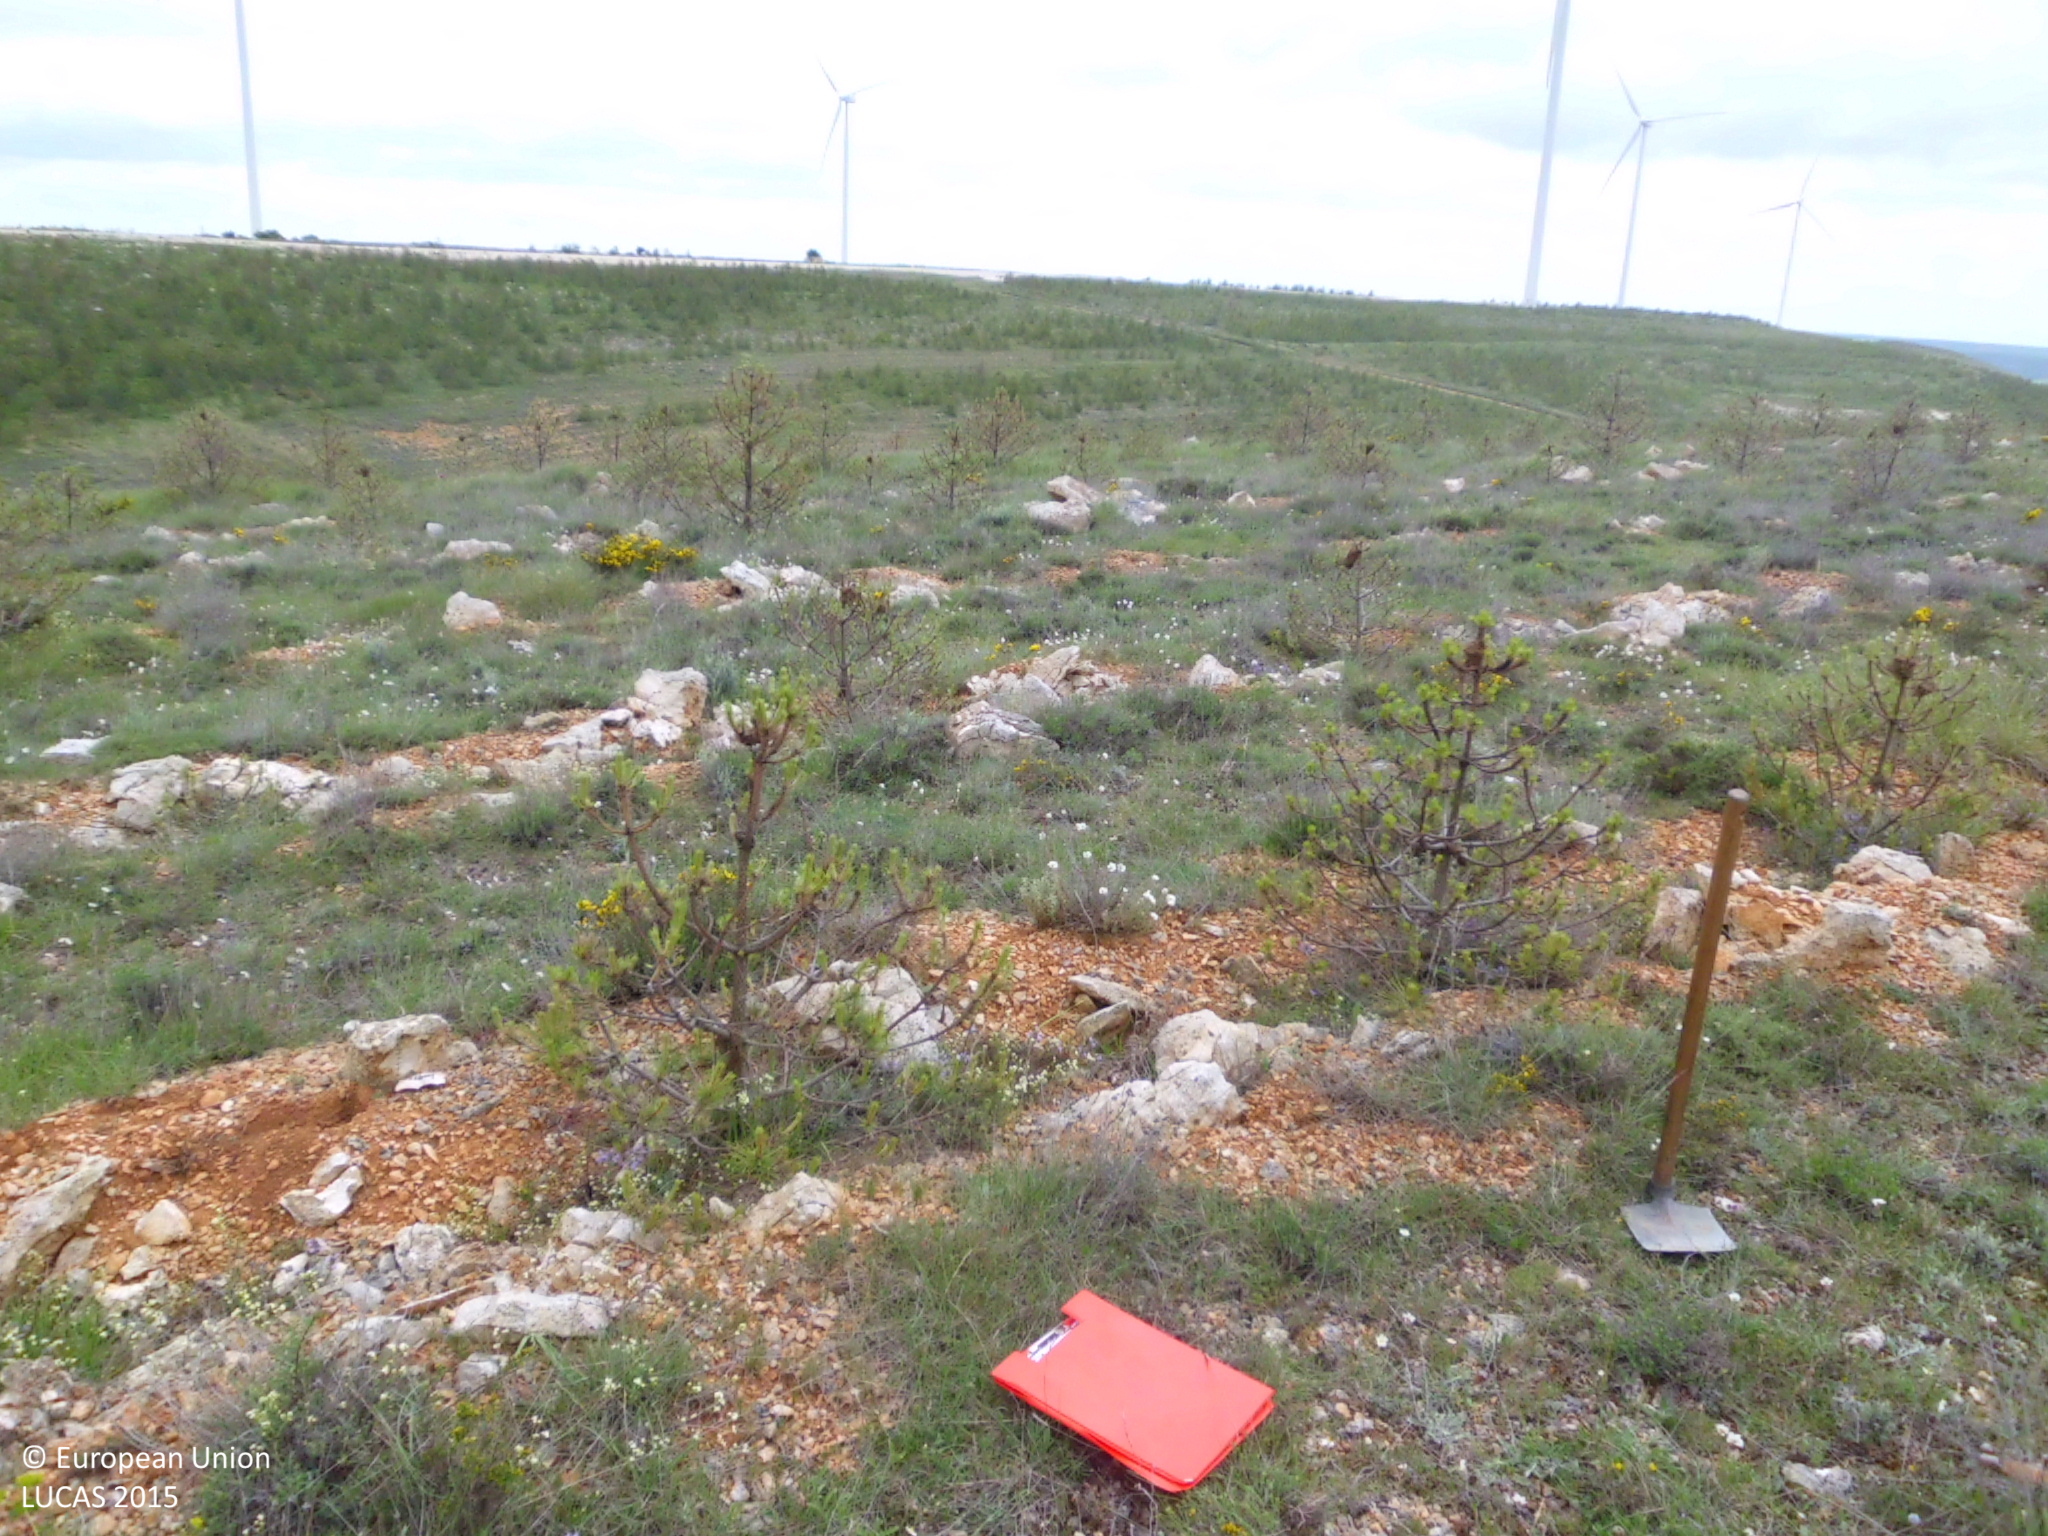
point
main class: Woodland
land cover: Pine dominated coniferous woodland
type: coniferous forest of the mediterranean region
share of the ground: > 75 %
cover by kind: herbaceous plants 60 %, unconsolidated bare surface 20 %, coniferous forest trees 15 %, shrubs 5 %
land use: Forestry
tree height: < 5 m
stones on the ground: 25 - 50 %
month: May
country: ES
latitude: 42.5485
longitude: -3.9124
